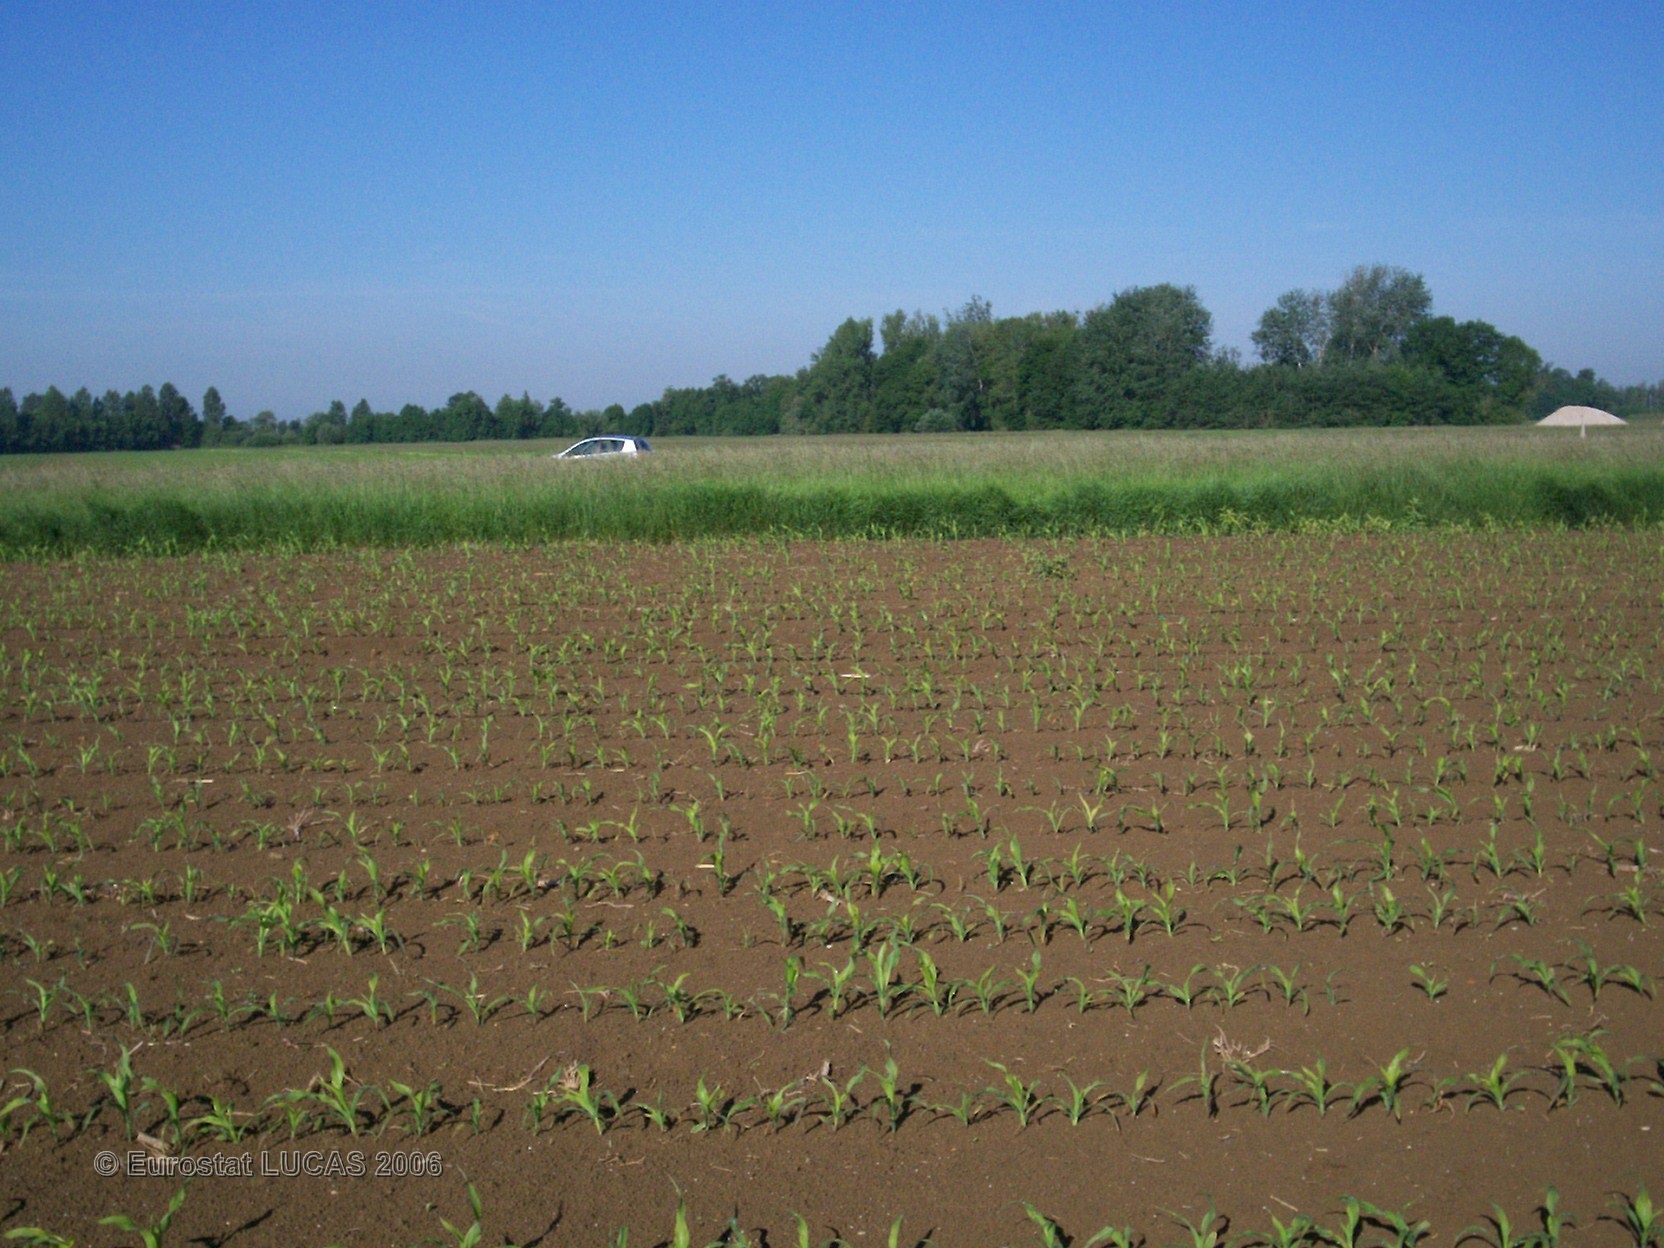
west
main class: Cropland
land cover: Maize
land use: Agriculture (excluding fallow land and kitchen gardens)
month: June
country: FR
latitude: 48.8426
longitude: 4.4783
